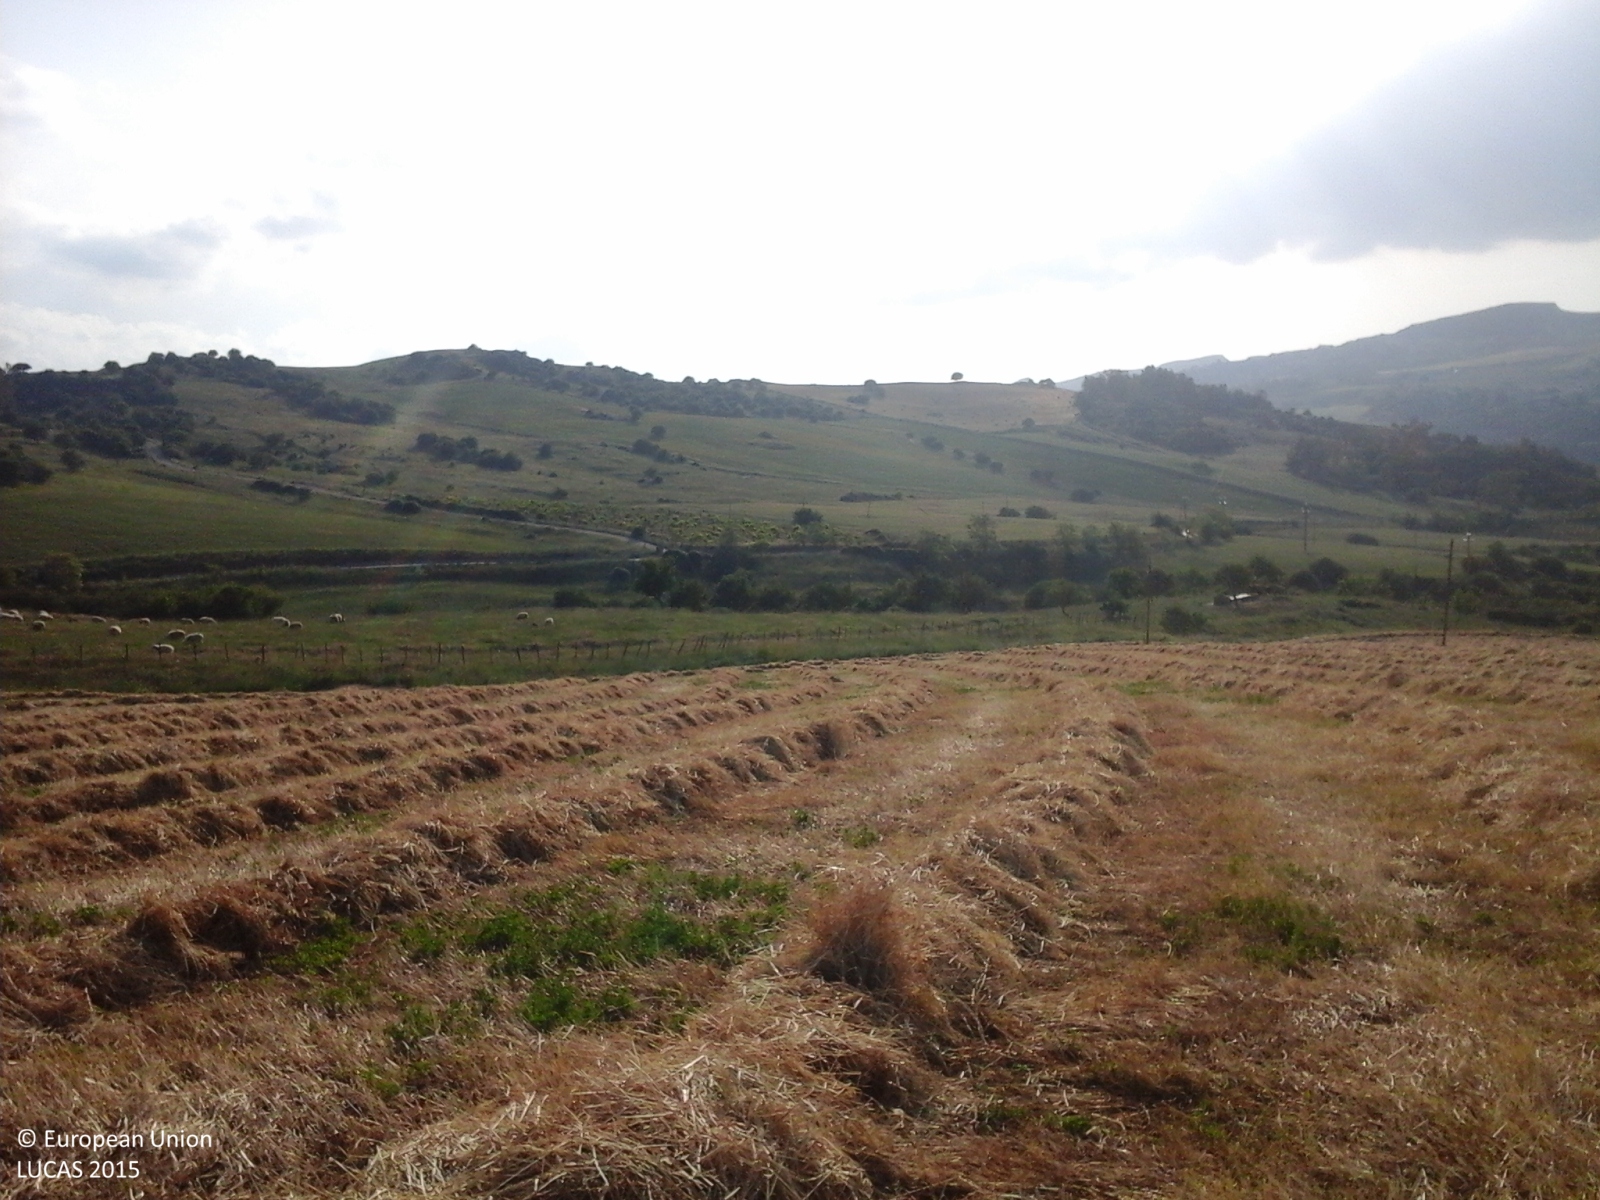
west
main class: Cropland
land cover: Other leguminous and mixtures for fodder
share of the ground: > 75 %
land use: Agriculture (excluding fallow land and kitchen gardens)
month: May
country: IT
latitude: 37.6871
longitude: 14.2896
